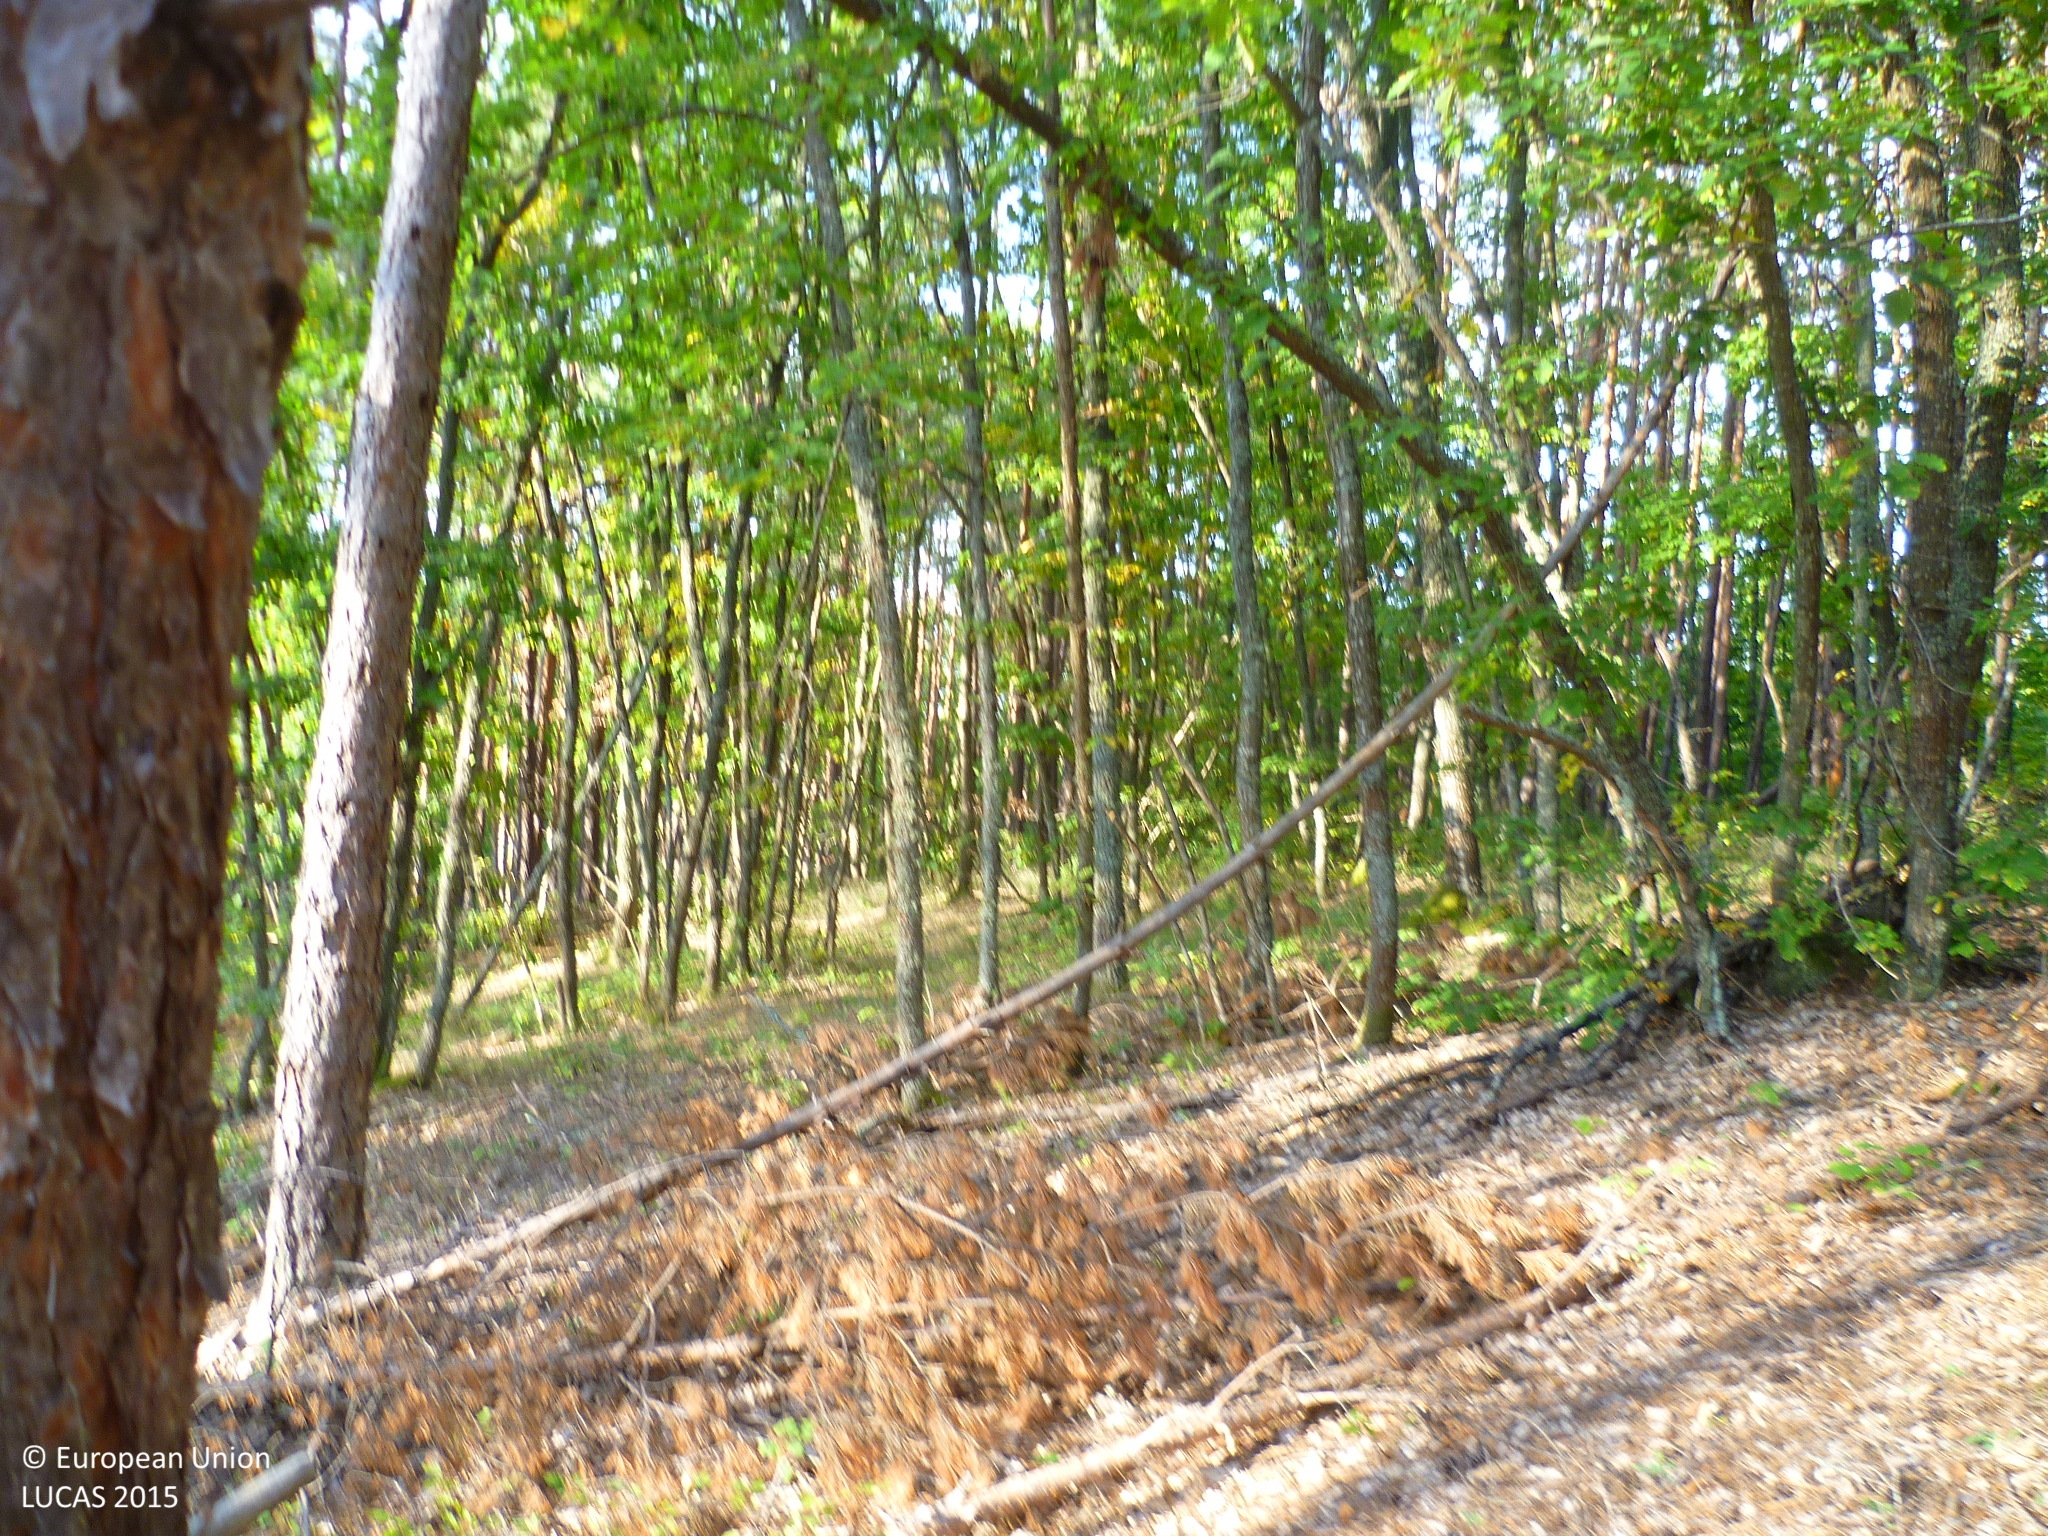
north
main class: Woodland
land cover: Pine dominated mixed woodland
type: hemiboreal forest and nemoral coniferous forest and mixed broadleaved-coniferous forest
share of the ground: > 75 %
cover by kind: coniferous forest trees 60 %, broadleaved forest trees 20 %, unconsolidated bare surface 15 %, herbaceous plants 5 %
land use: Forestry
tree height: > 5 m
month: October
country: BG
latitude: 42.7848
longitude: 22.6783
